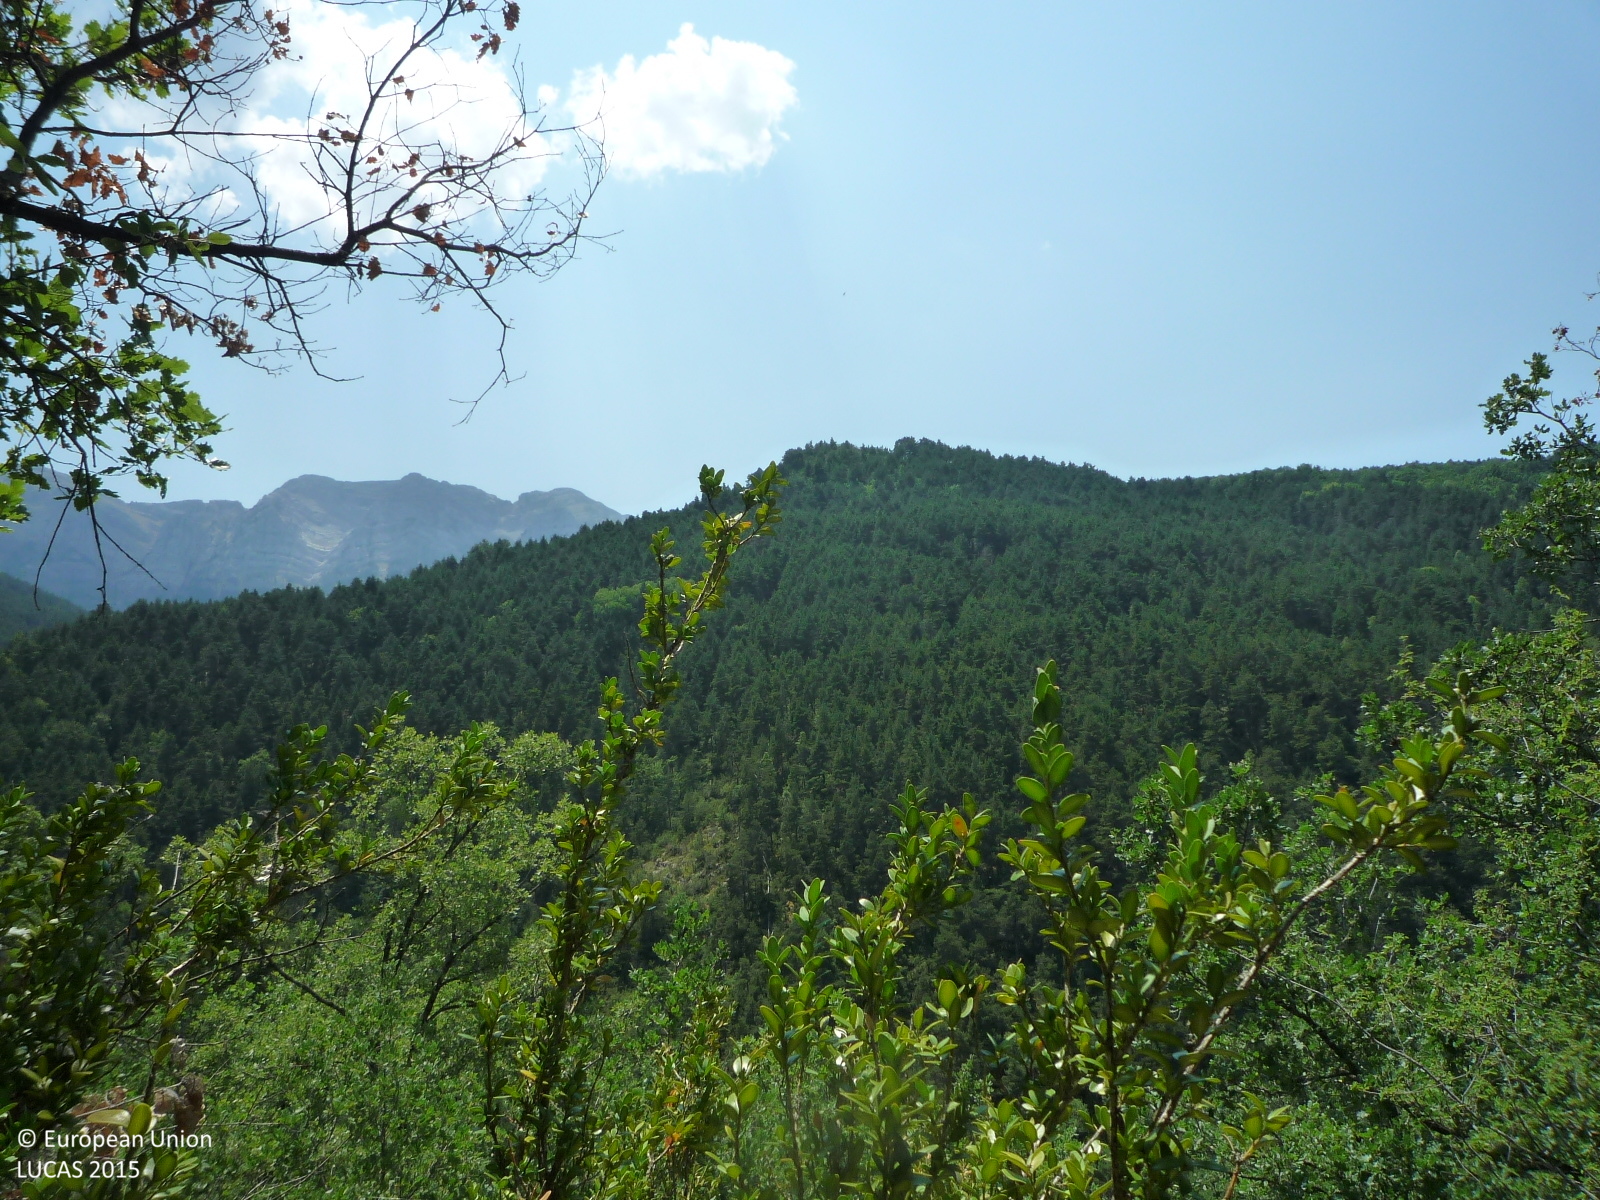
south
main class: Woodland
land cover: Broadleaved woodland
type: acidophilous oak and oak-birch forest
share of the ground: > 75 %
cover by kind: broadleaved forest trees 60 %, shrubs 20 %, herbaceous plants 10 %, lichens and mosses 10 %
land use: Semi-natural and natural areas not in use
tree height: > 5 m
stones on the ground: > 50 %
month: June
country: ES
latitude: 42.3229
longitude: 1.6016
